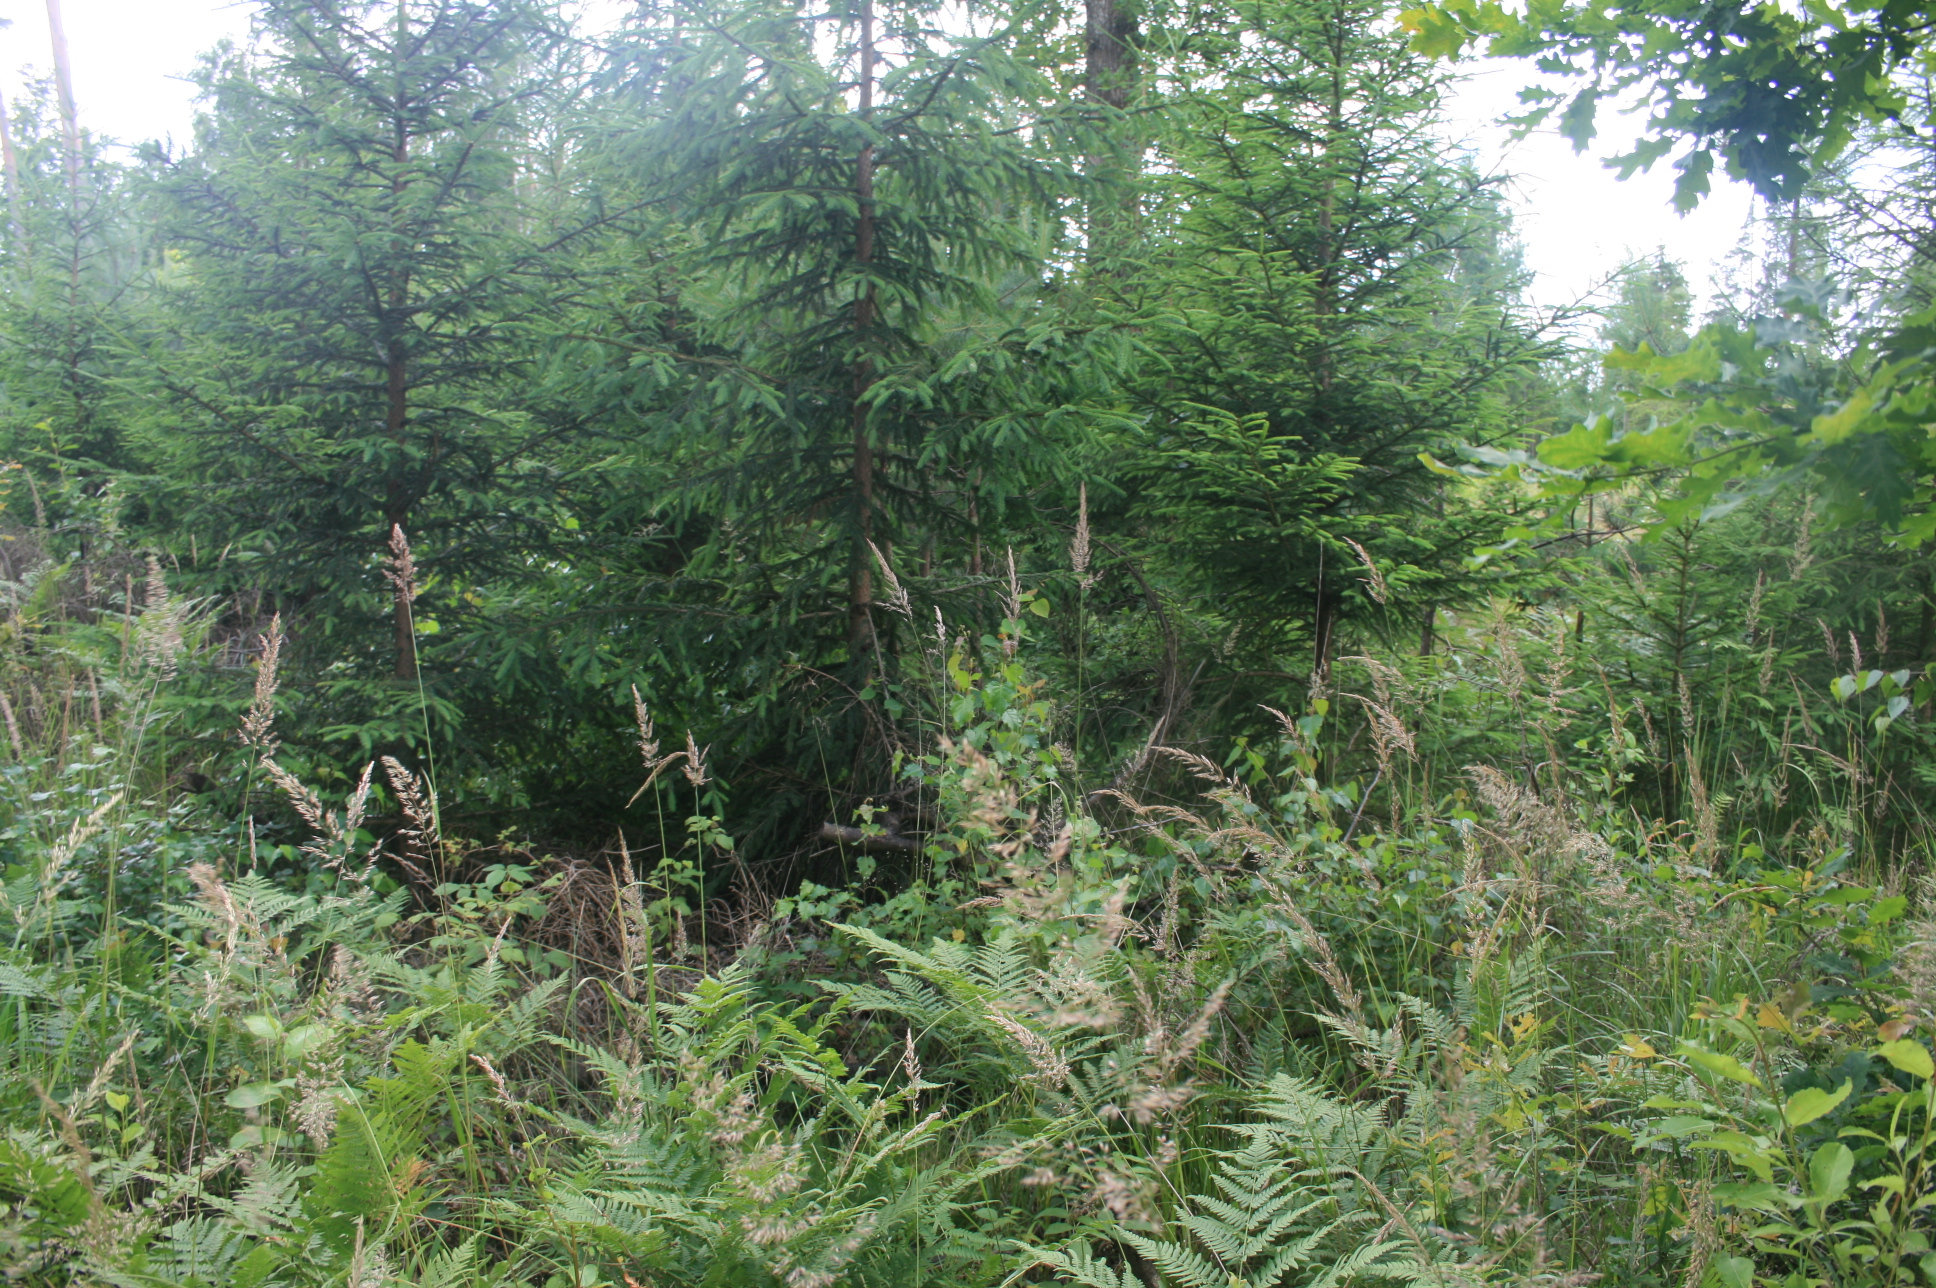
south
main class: Woodland
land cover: Spruce dominated mixed woodland
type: hemiboreal forest and nemoral coniferous forest and mixed broadleaved-coniferous forest
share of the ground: 50 - 75 %
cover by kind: coniferous forest trees 45 %, herbaceous plants 30 %, broadleaved forest trees 25 %
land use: Forestry
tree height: > 5 m
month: July
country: LT
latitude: 55.8268
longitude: 21.3608
